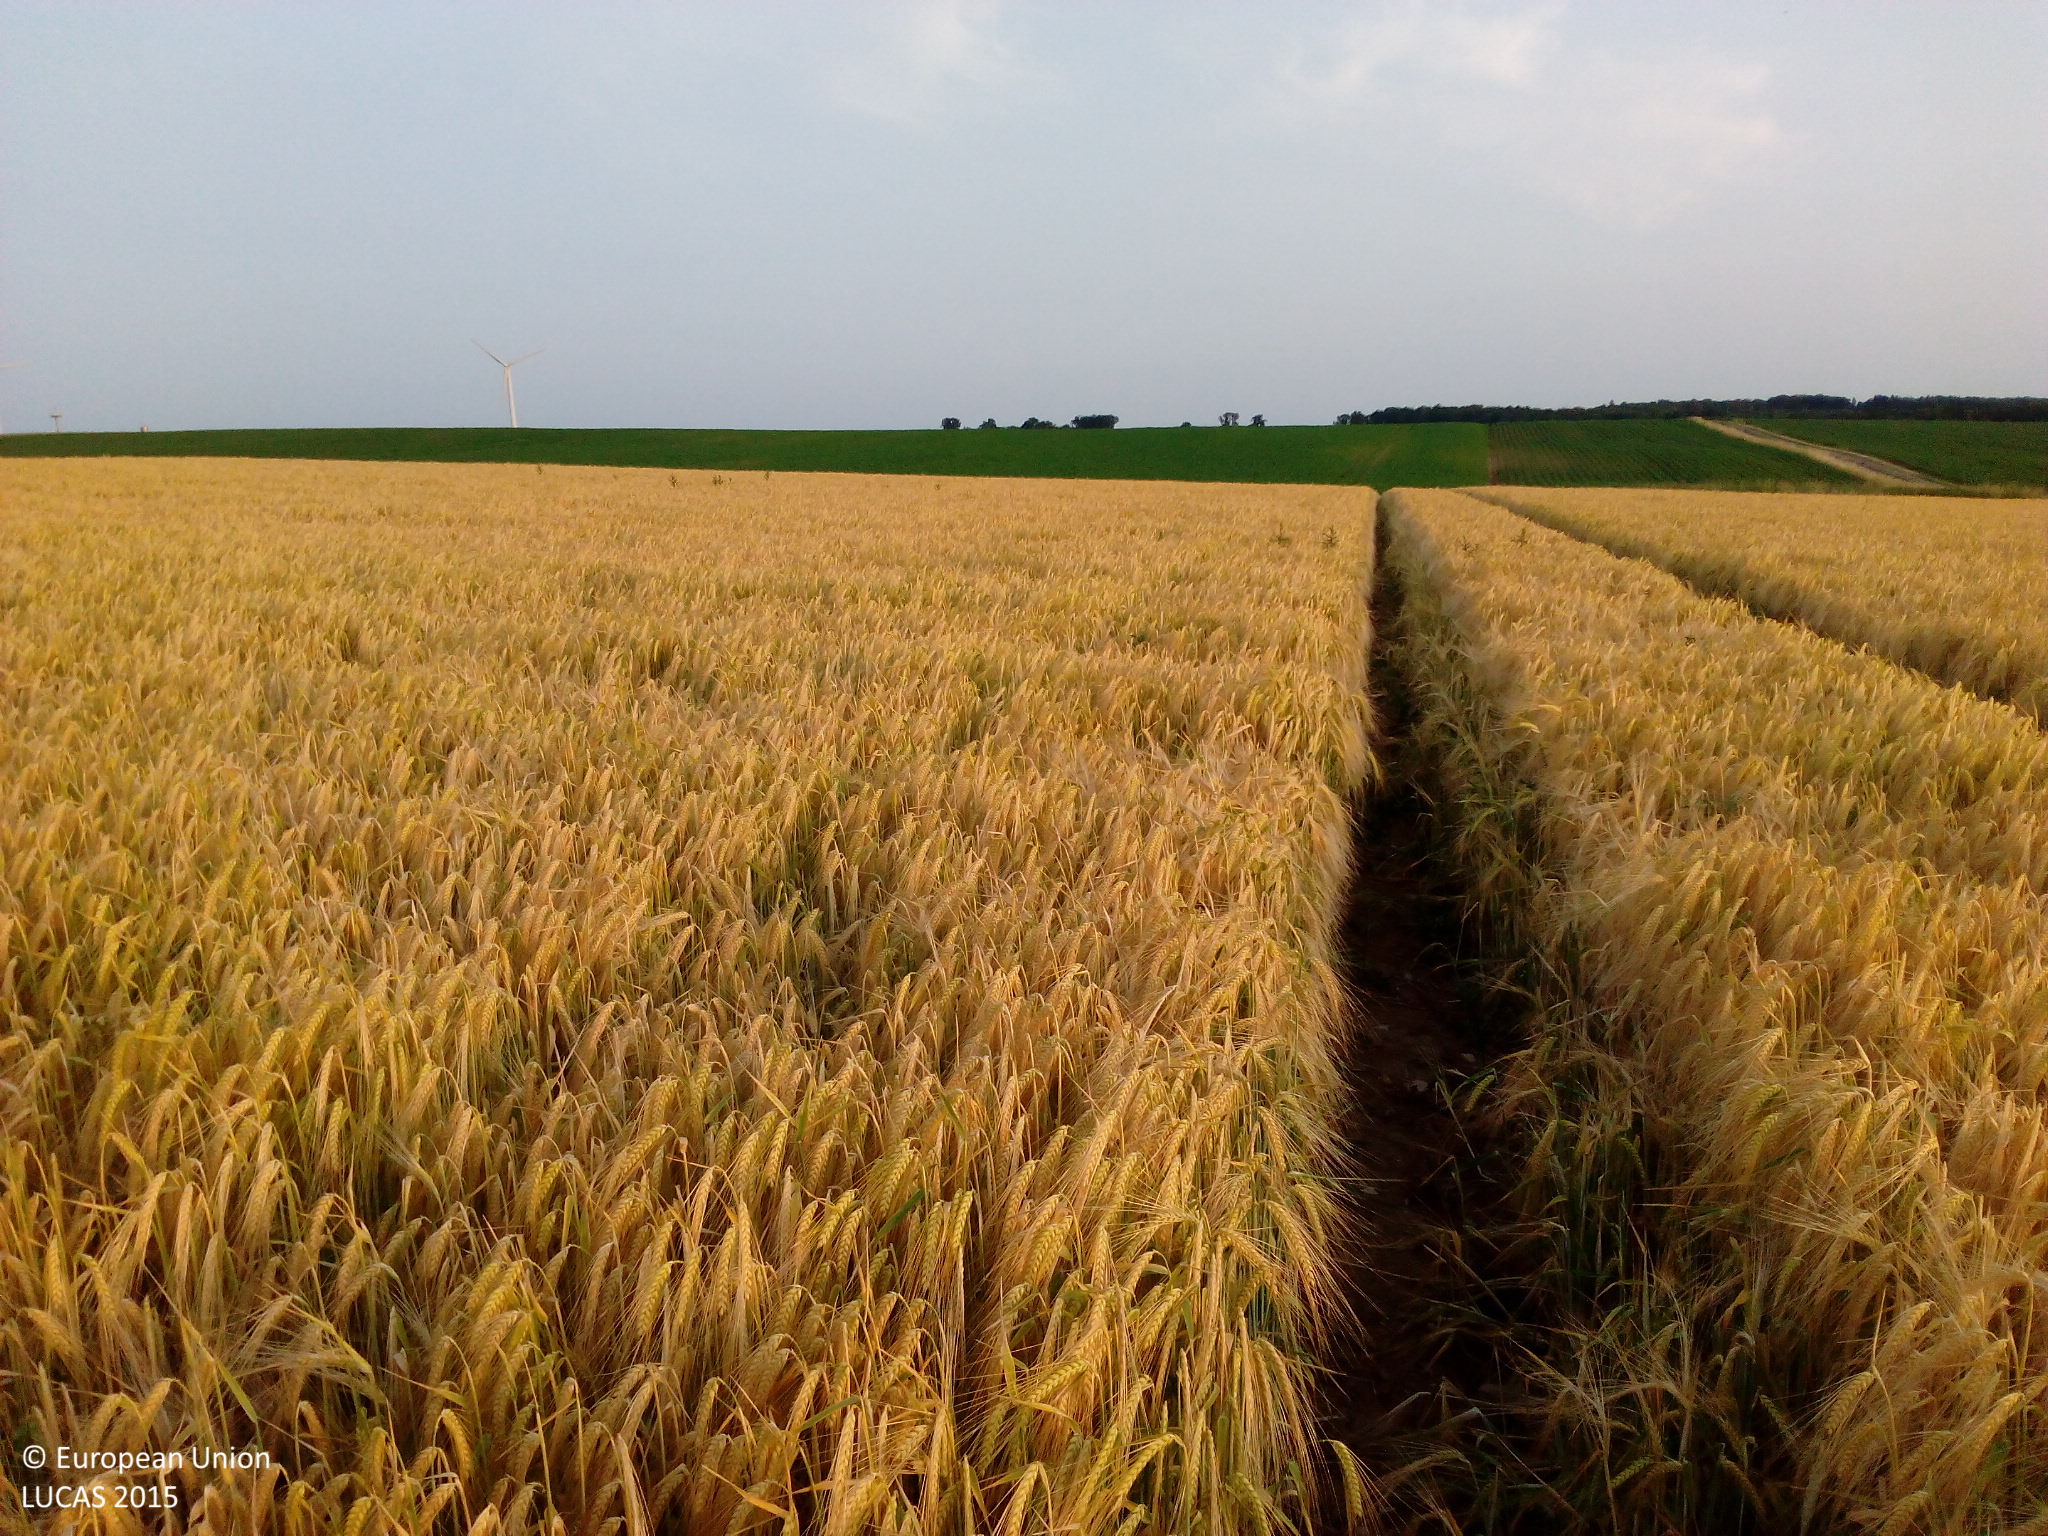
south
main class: Cropland
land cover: Barley
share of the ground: > 75 %
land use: Agriculture (excluding fallow land and kitchen gardens)
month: June
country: DE
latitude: 49.3381
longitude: 9.5735
